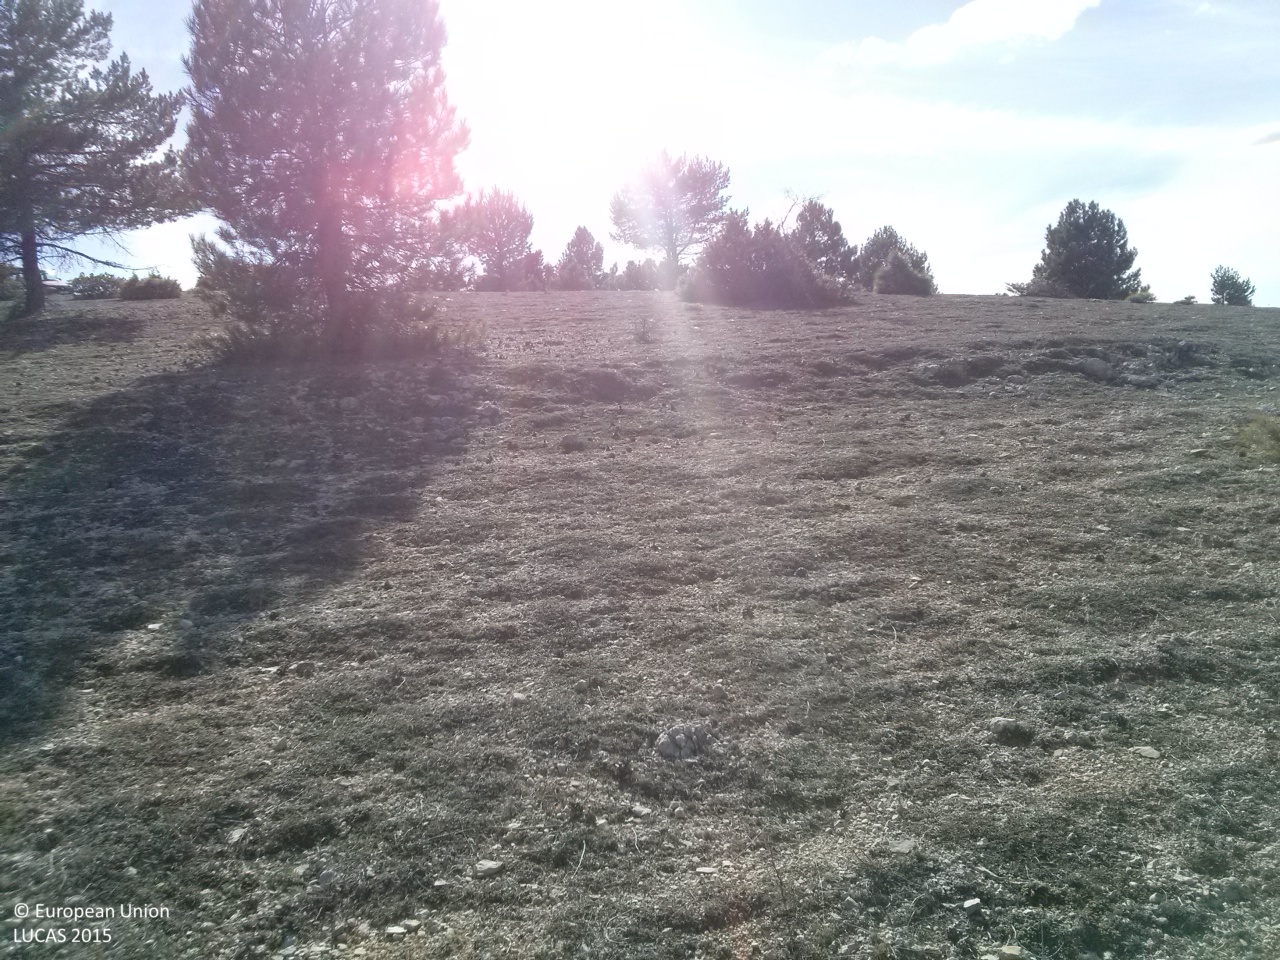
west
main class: Grassland
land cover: Grassland without tree/shrub cover
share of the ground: 25 - 50 %
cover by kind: unconsolidated bare surface 55 %, herbaceous plants 40 %, shrubs 5 %
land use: Agriculture (excluding fallow land and kitchen gardens)
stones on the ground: 25 - 50 %
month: April
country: ES
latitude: 40.1689
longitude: -1.8388
